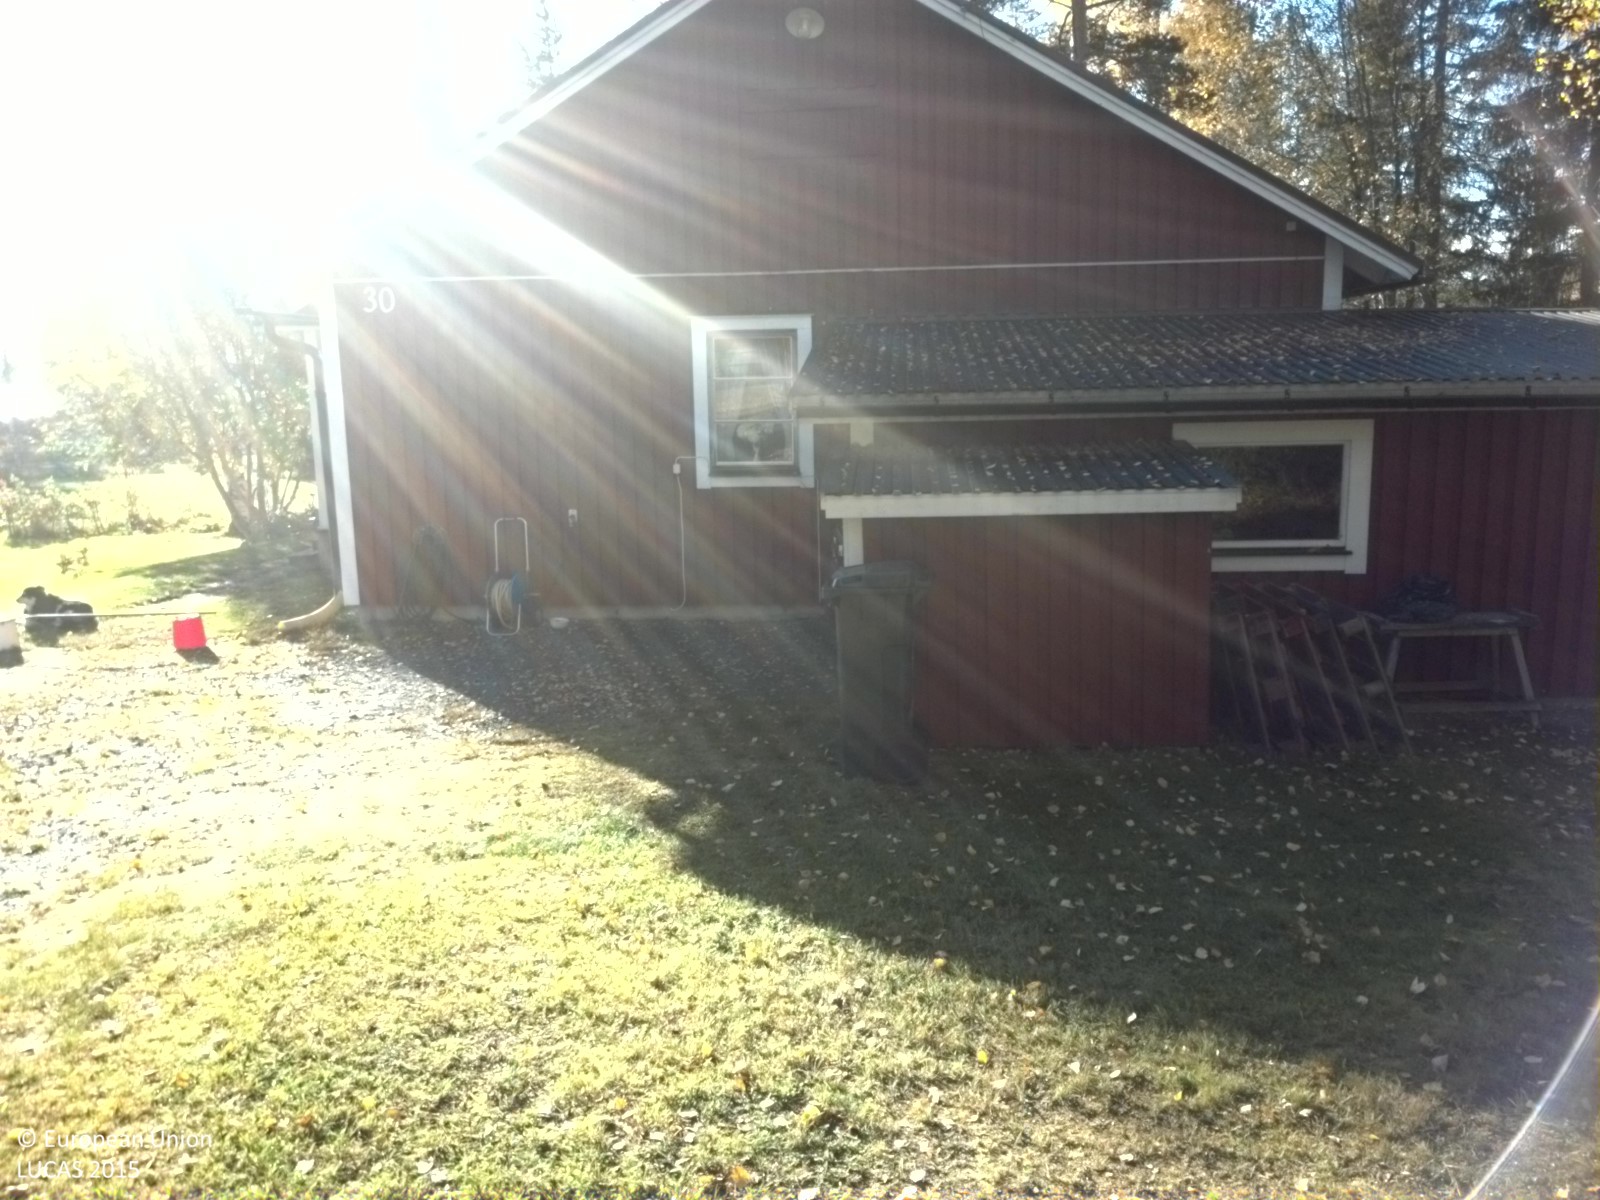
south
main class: Woodland
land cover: Spruce dominated mixed woodland
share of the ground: 50 - 75 %
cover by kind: coniferous forest trees 40 %, shrubs 30 %, broadleaved forest trees 20 %, herbaceous plants 10 %
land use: Residential
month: October
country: SE
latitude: 65.7620
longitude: 21.3876
